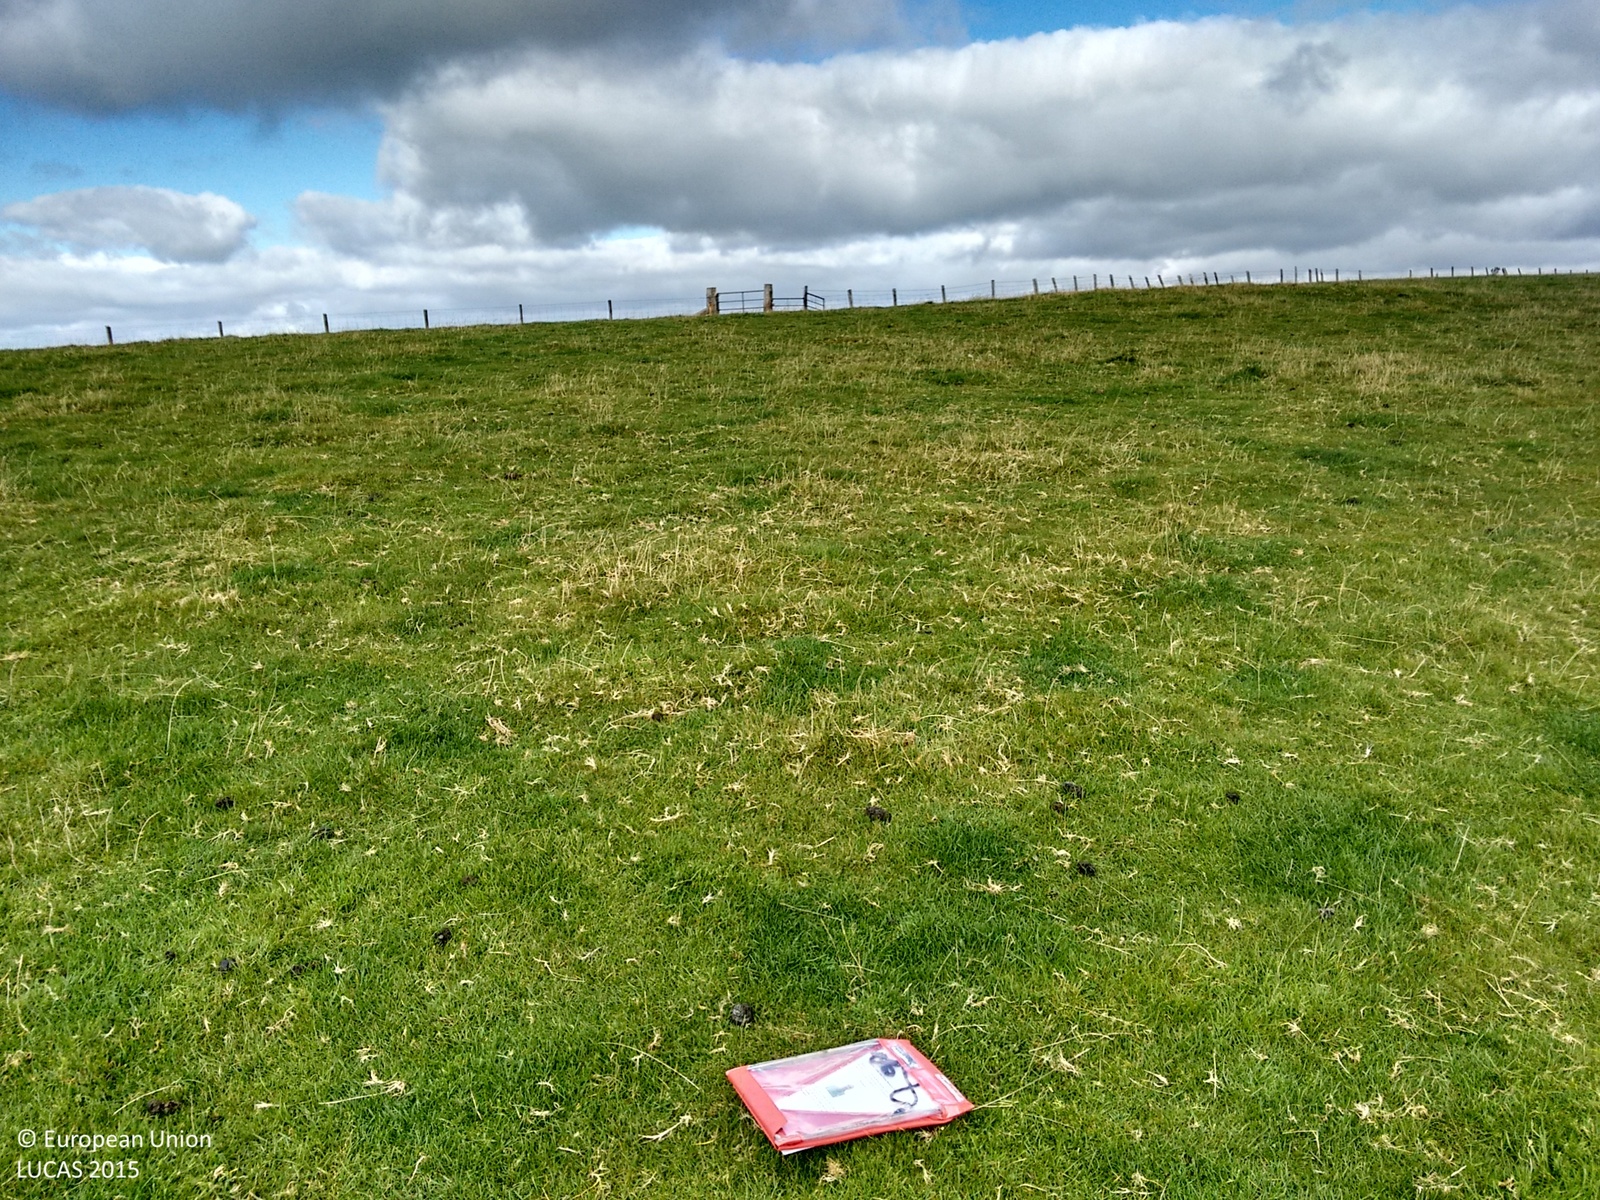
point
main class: Grassland
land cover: Grassland without tree/shrub cover
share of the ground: > 75 %
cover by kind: herbaceous plants 100 %
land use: Agriculture (excluding fallow land and kitchen gardens)
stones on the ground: < 10 %
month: October
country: GB
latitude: 52.4235
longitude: -3.3306
